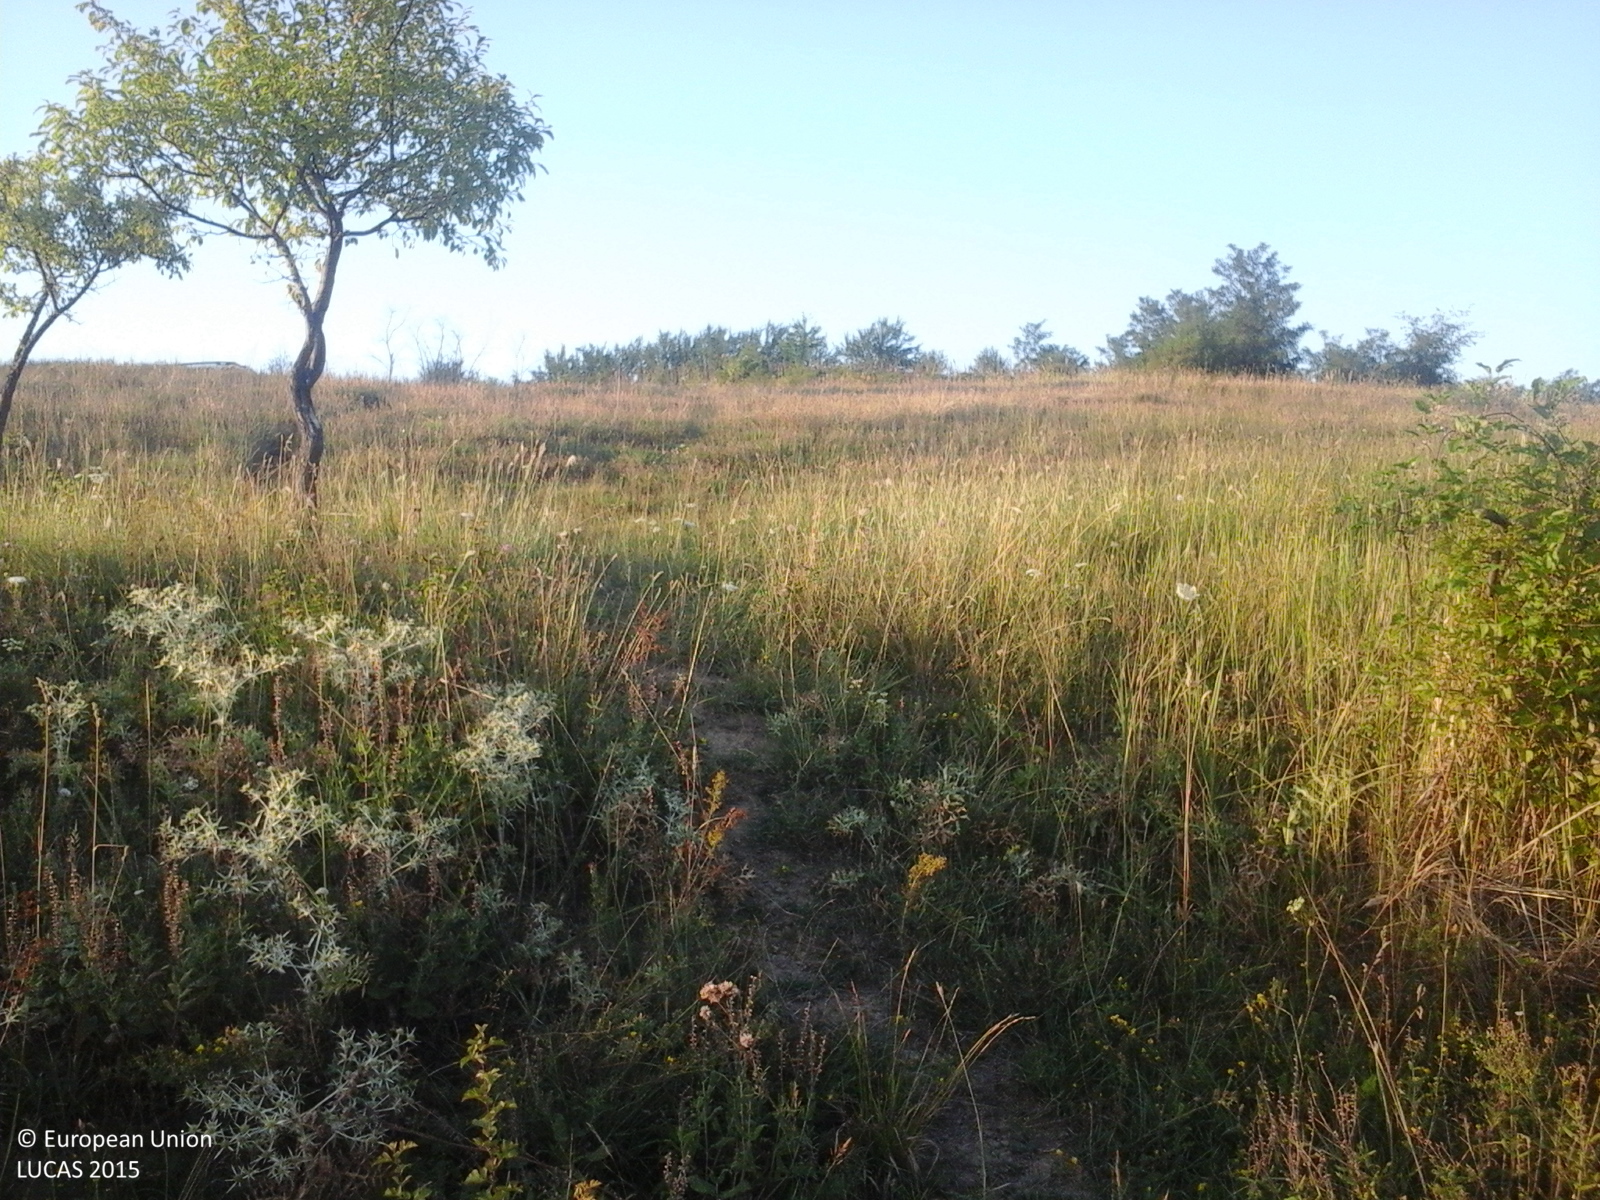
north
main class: Grassland
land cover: Grassland with sparse tree/shrub cover
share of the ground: > 75 %
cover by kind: herbaceous plants 85 %, shrubs 10 %, broadleaved forest trees 5 %
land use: Agriculture (excluding fallow land and kitchen gardens)
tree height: < 5 m
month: August
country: RO
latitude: 46.2719
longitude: 26.8419
